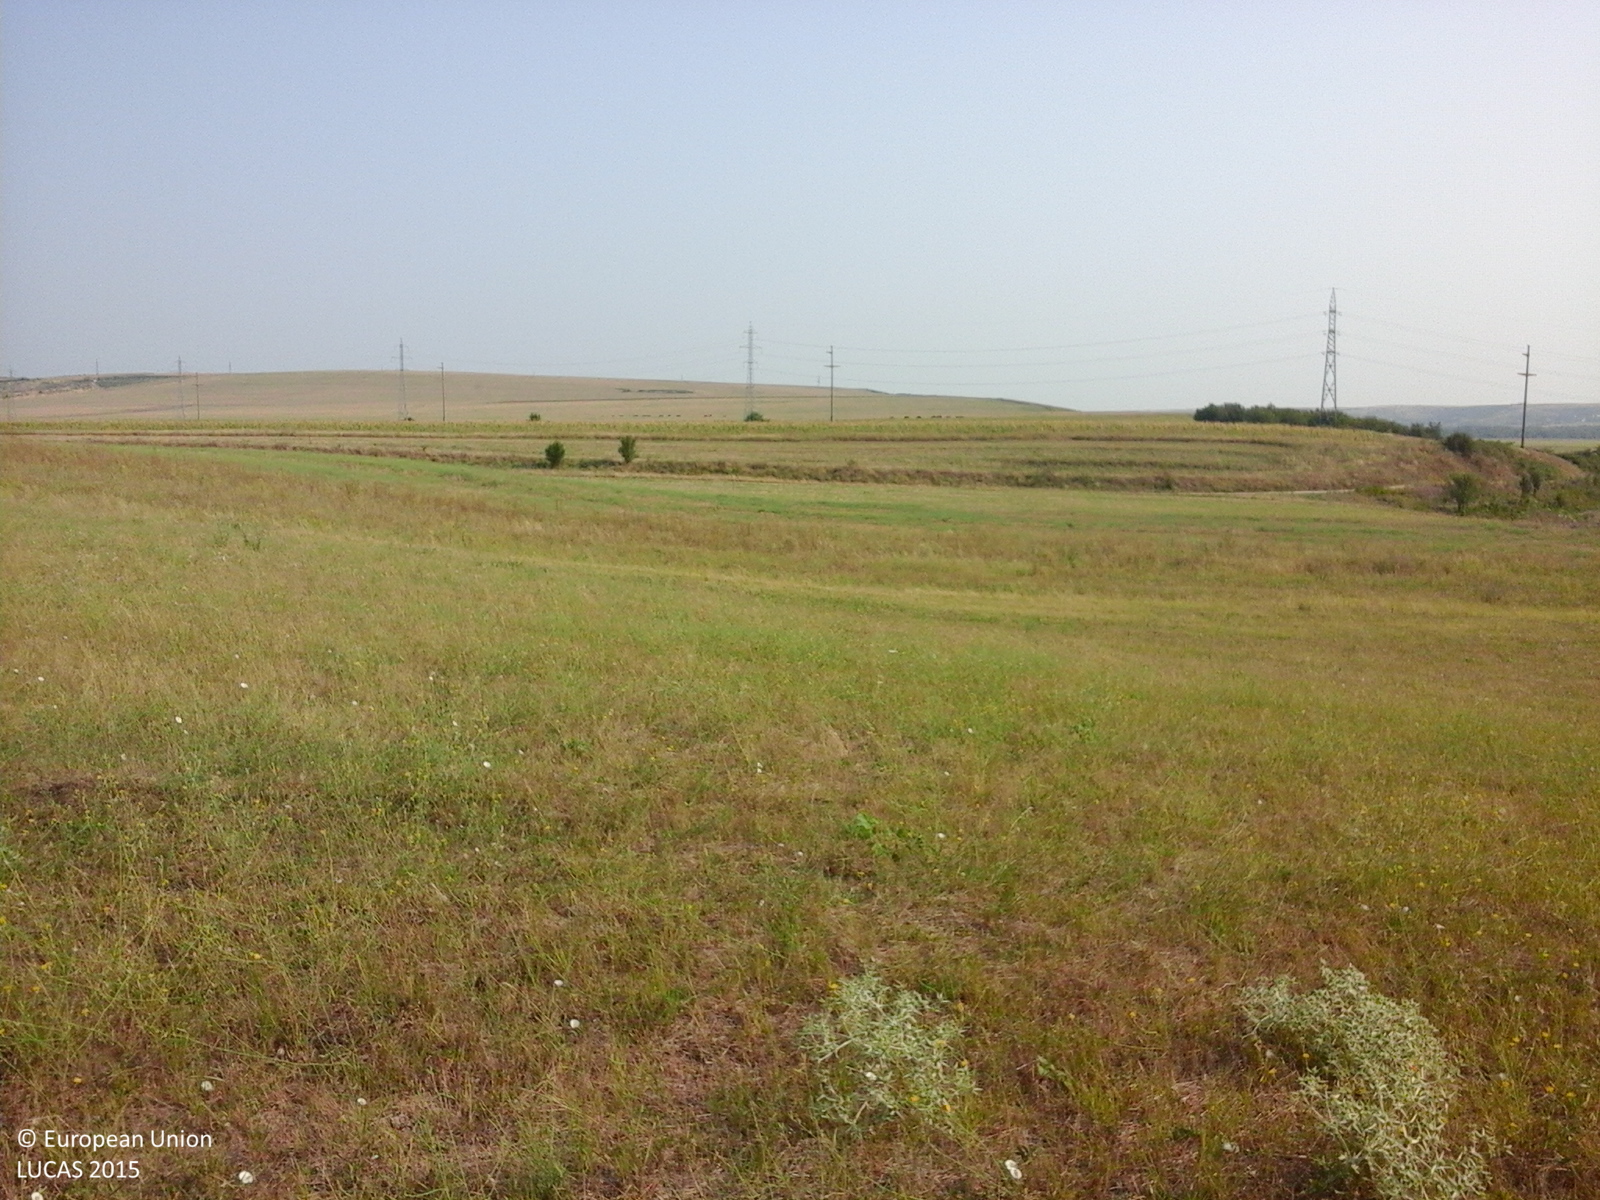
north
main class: Grassland
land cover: Spontaneously vegetated surfaces
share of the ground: > 75 %
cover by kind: herbaceous plants 100 %
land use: Fallow land
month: August
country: RO
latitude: 44.3981
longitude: 23.7544
